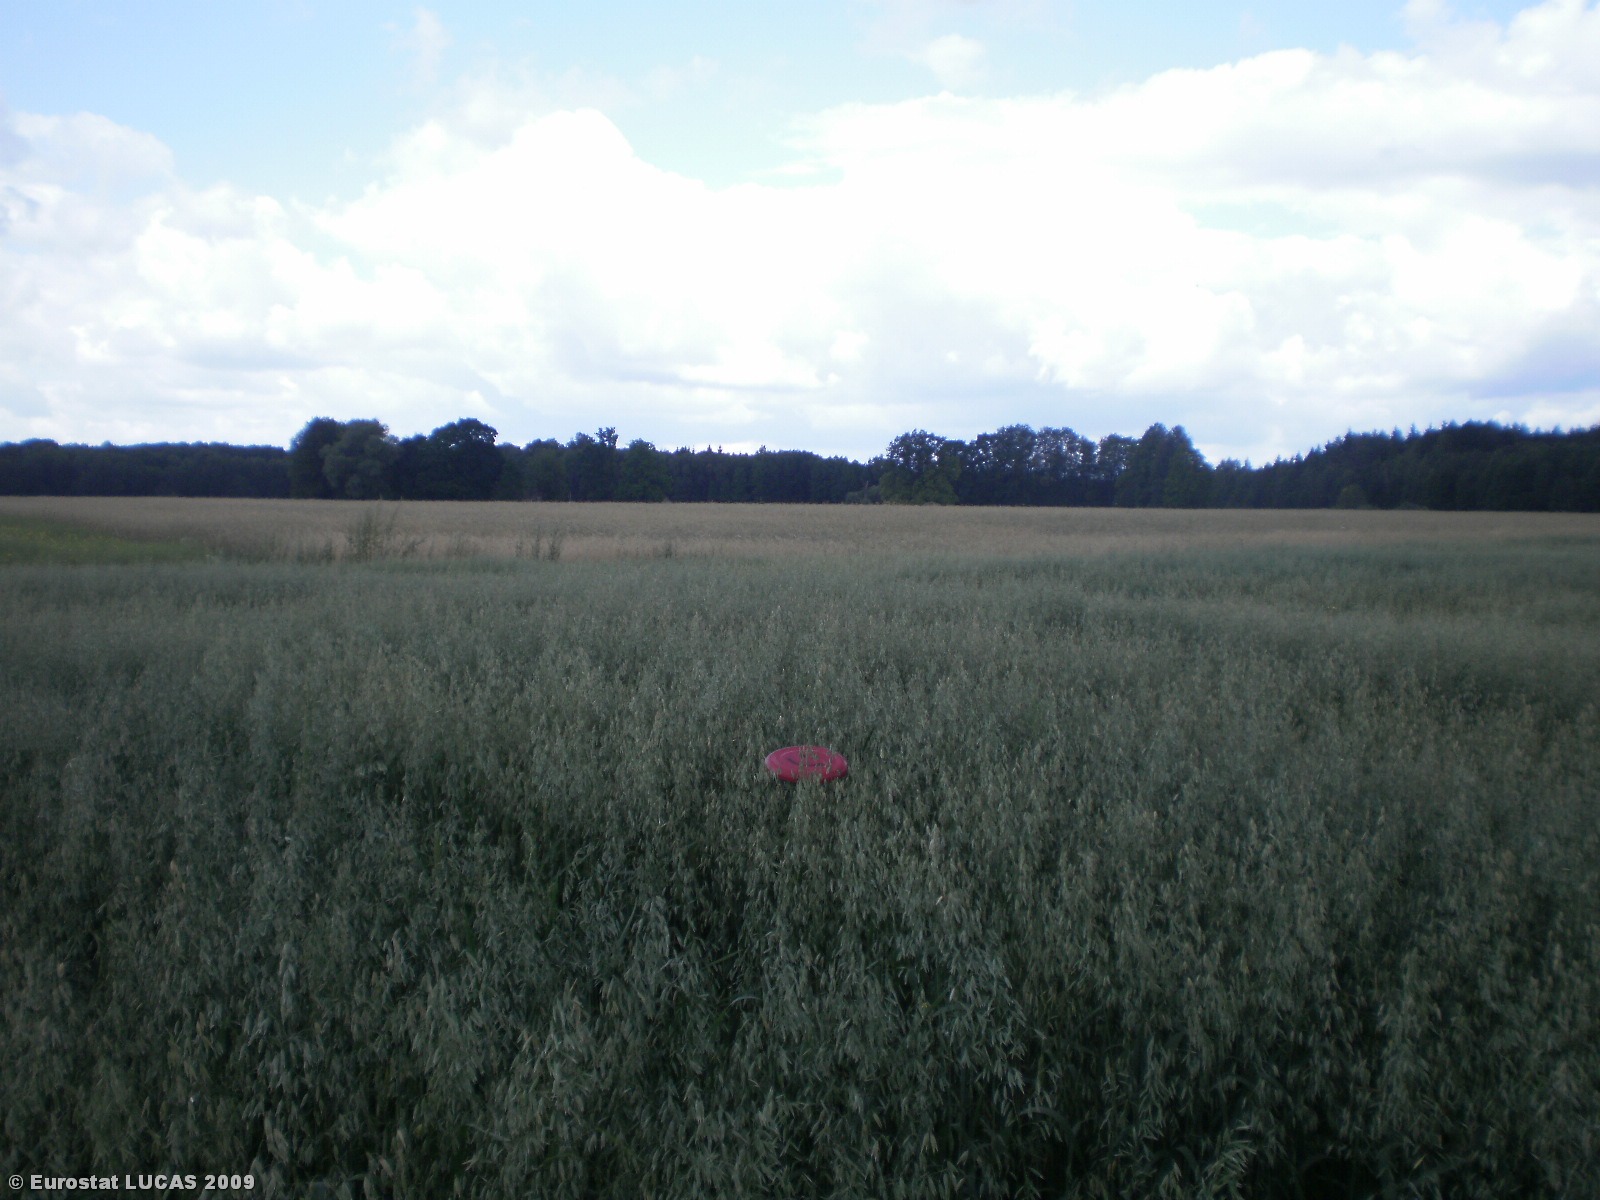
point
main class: Cropland
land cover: Oats
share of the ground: > 75 %
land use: Agriculture (excluding fallow land and kitchen gardens)
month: July
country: LT
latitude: 56.0885
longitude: 25.1398
